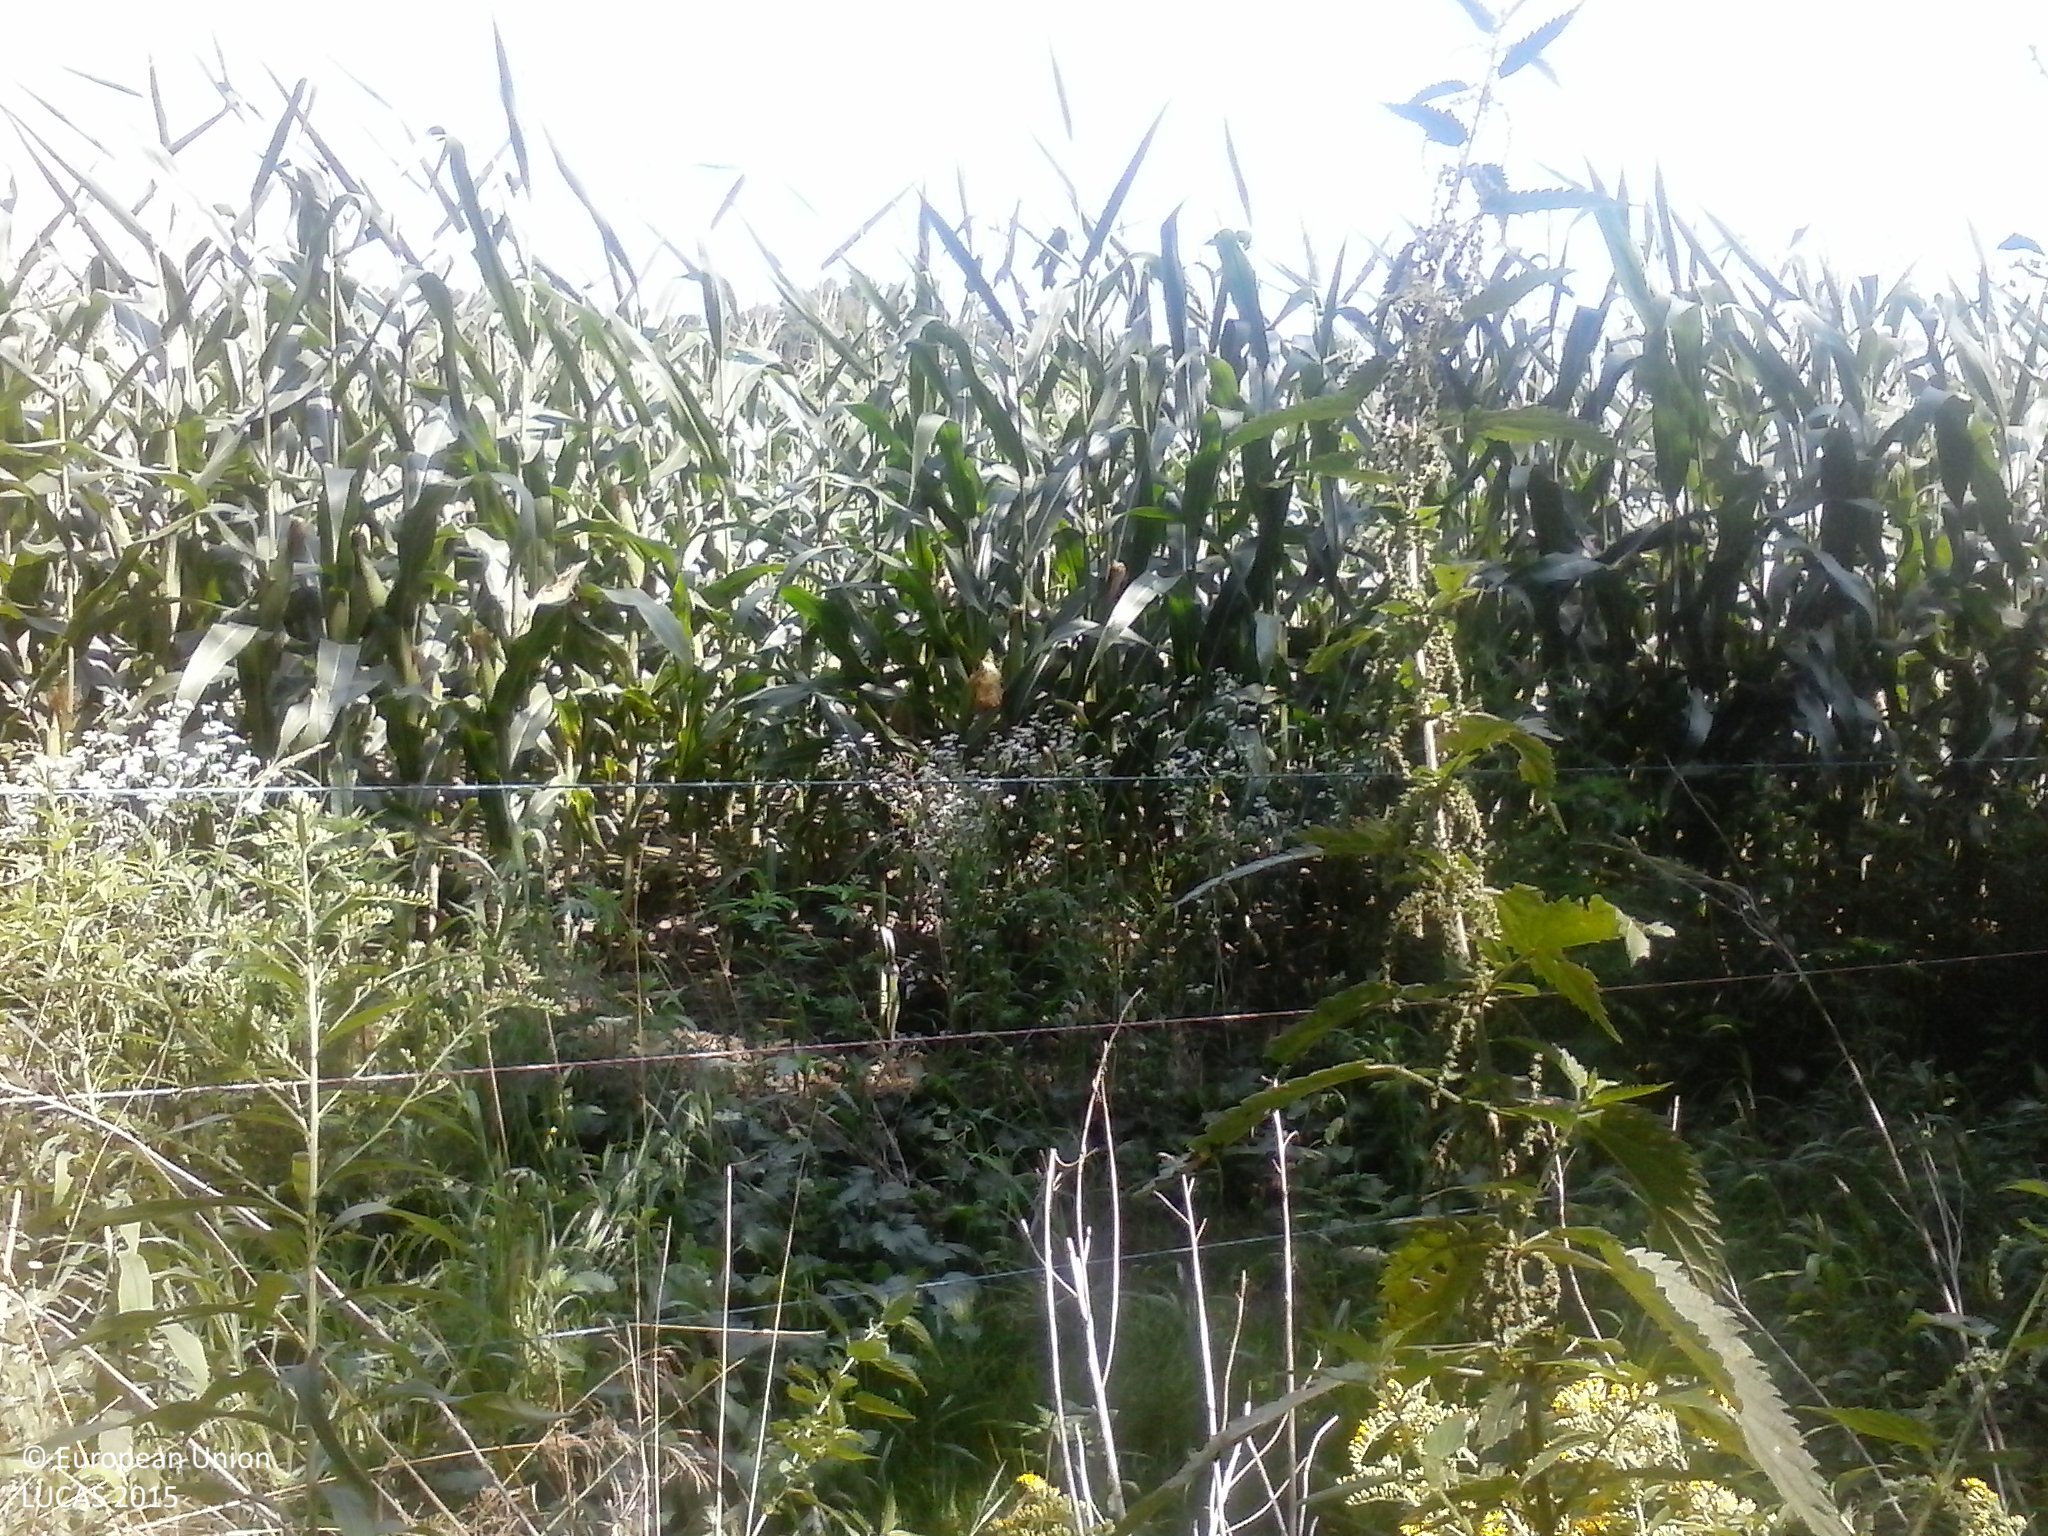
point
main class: Cropland
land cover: Maize
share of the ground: > 75 %
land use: Agriculture (excluding fallow land and kitchen gardens)
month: August
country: HU
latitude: 45.8993
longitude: 17.8540
